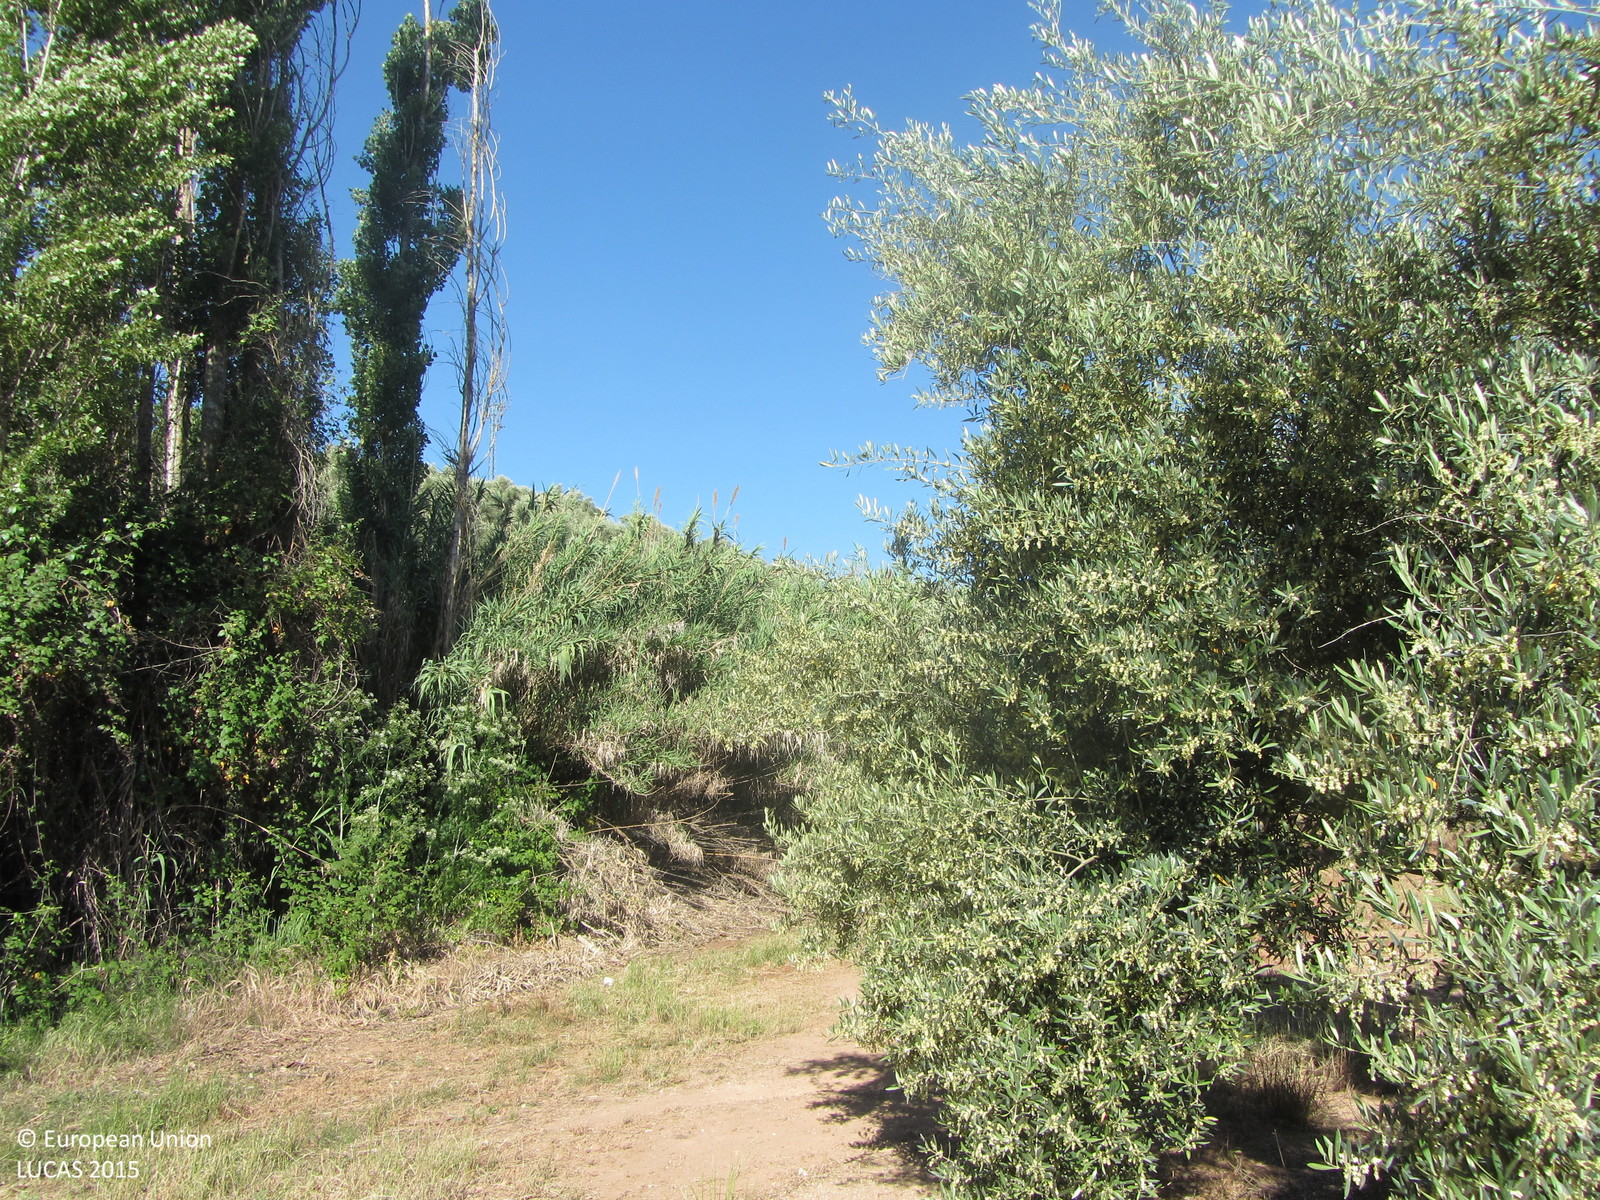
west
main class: Cropland
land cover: Olive groves
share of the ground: 25 - 50 %
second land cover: Spontaneously vegetated surfaces
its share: 25 - 50 %
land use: Agriculture (excluding fallow land and kitchen gardens)
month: May
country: ES
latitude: 38.1946
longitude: -3.0968
